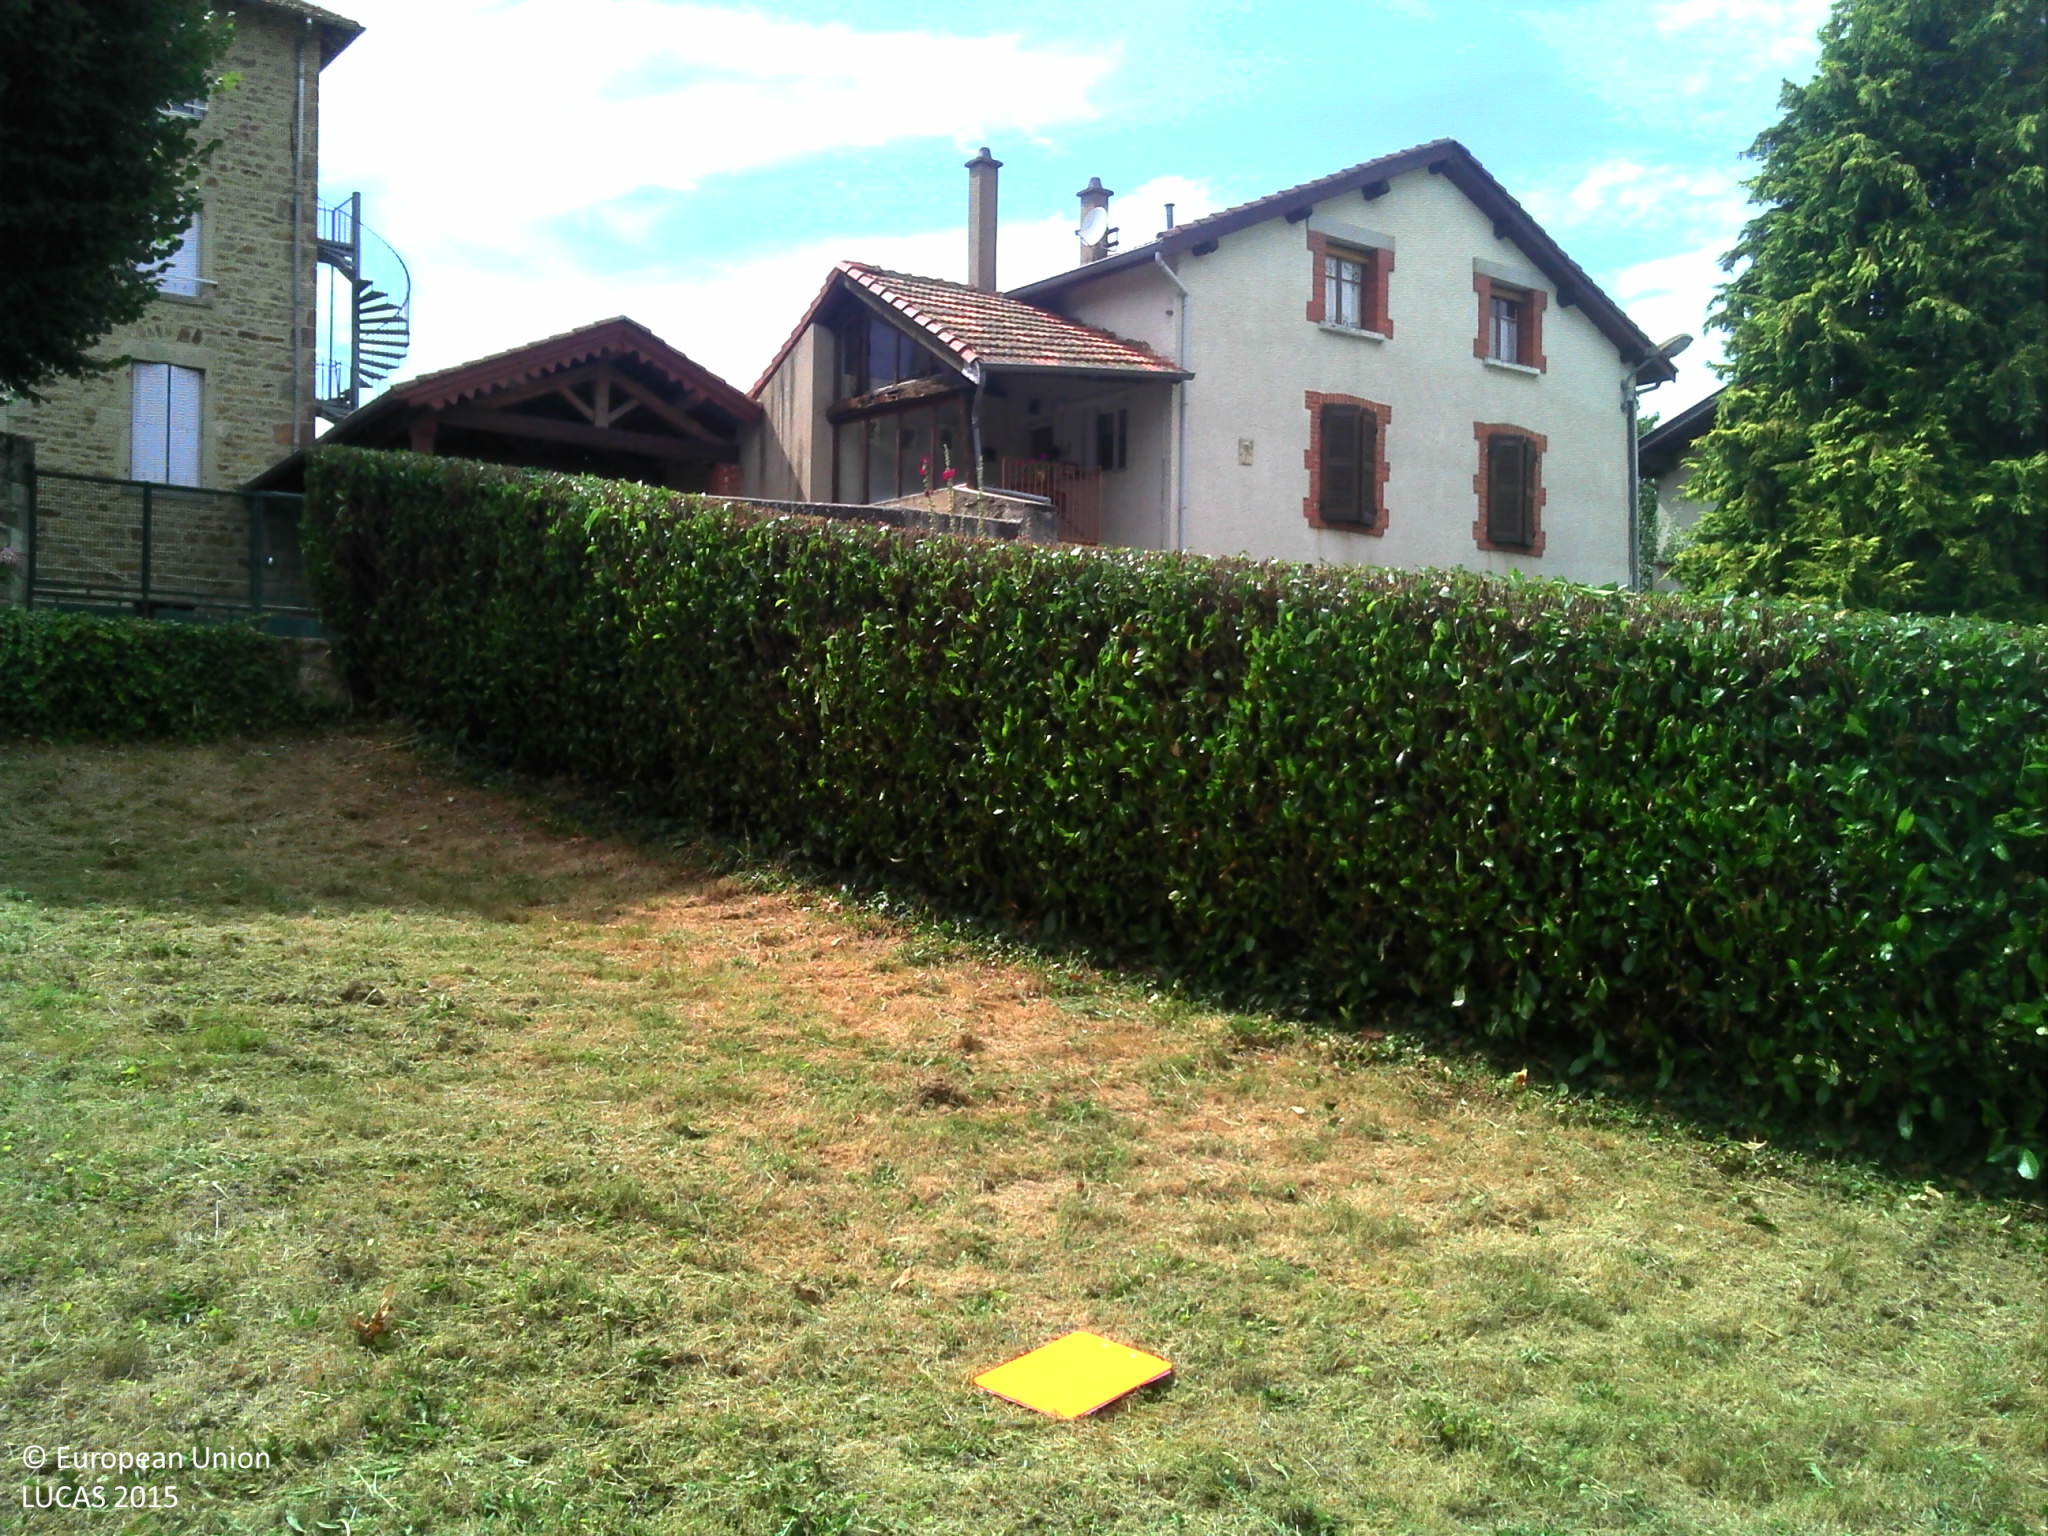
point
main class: Grassland
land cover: Grassland without tree/shrub cover
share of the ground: > 75 %
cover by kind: herbaceous plants 100 %
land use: Residential
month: July
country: FR
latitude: 45.6140
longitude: 4.5022
